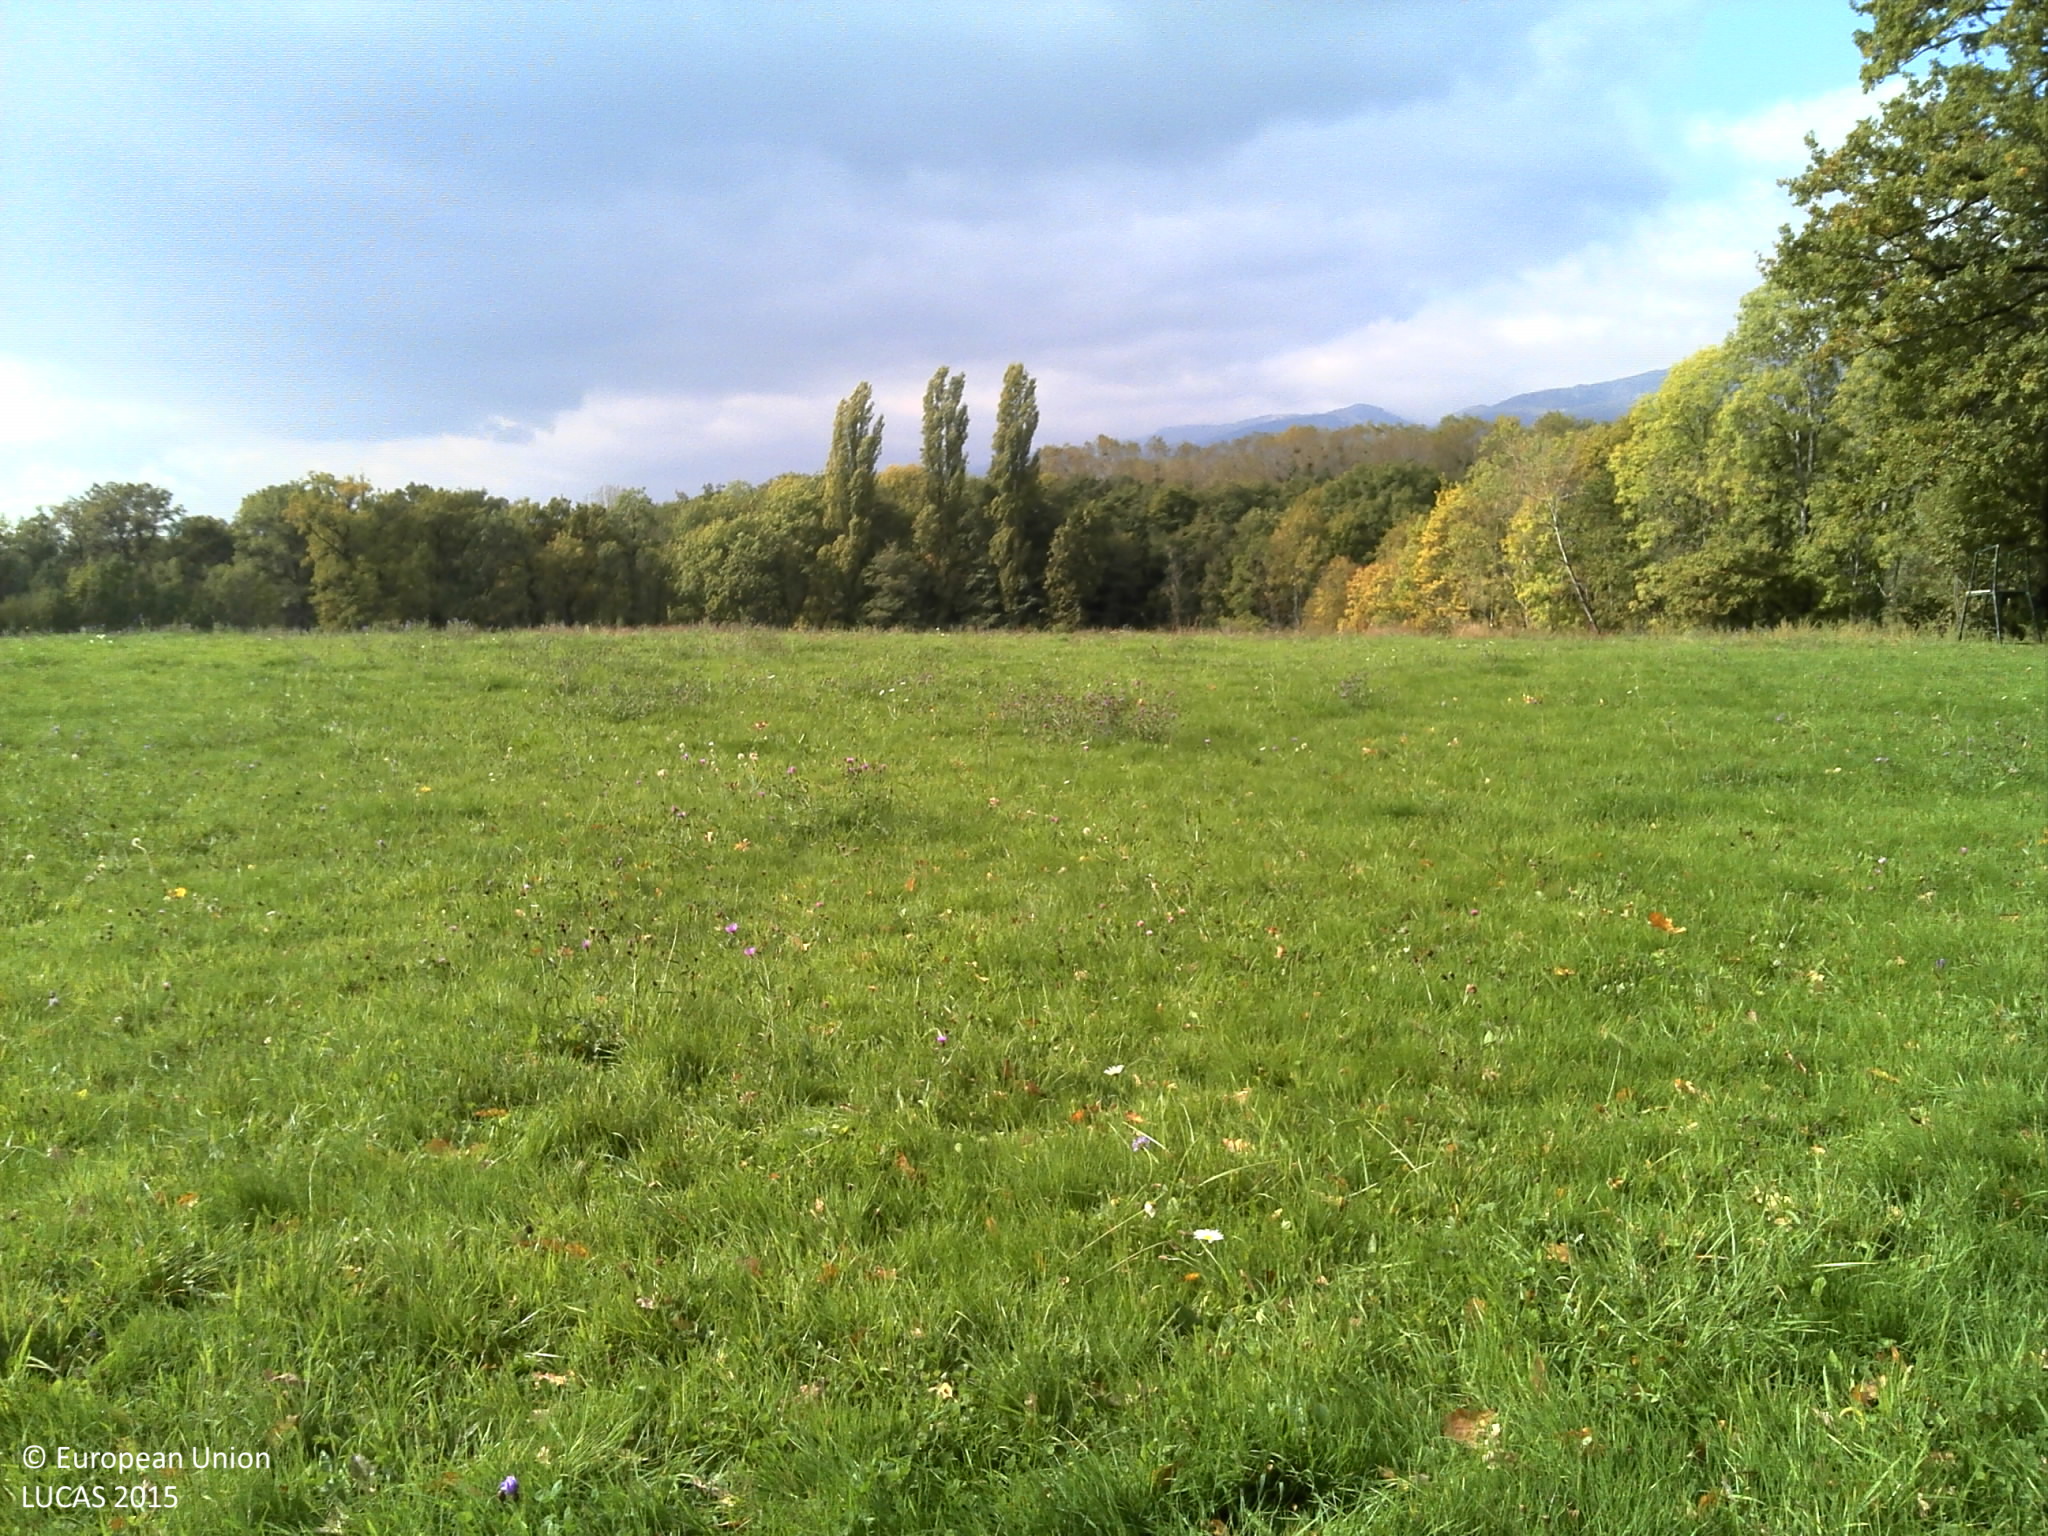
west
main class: Grassland
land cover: Grassland without tree/shrub cover
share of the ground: > 75 %
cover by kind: herbaceous plants 100 %
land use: Agriculture (excluding fallow land and kitchen gardens)
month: October
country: FR
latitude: 46.3160
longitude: 6.0943
